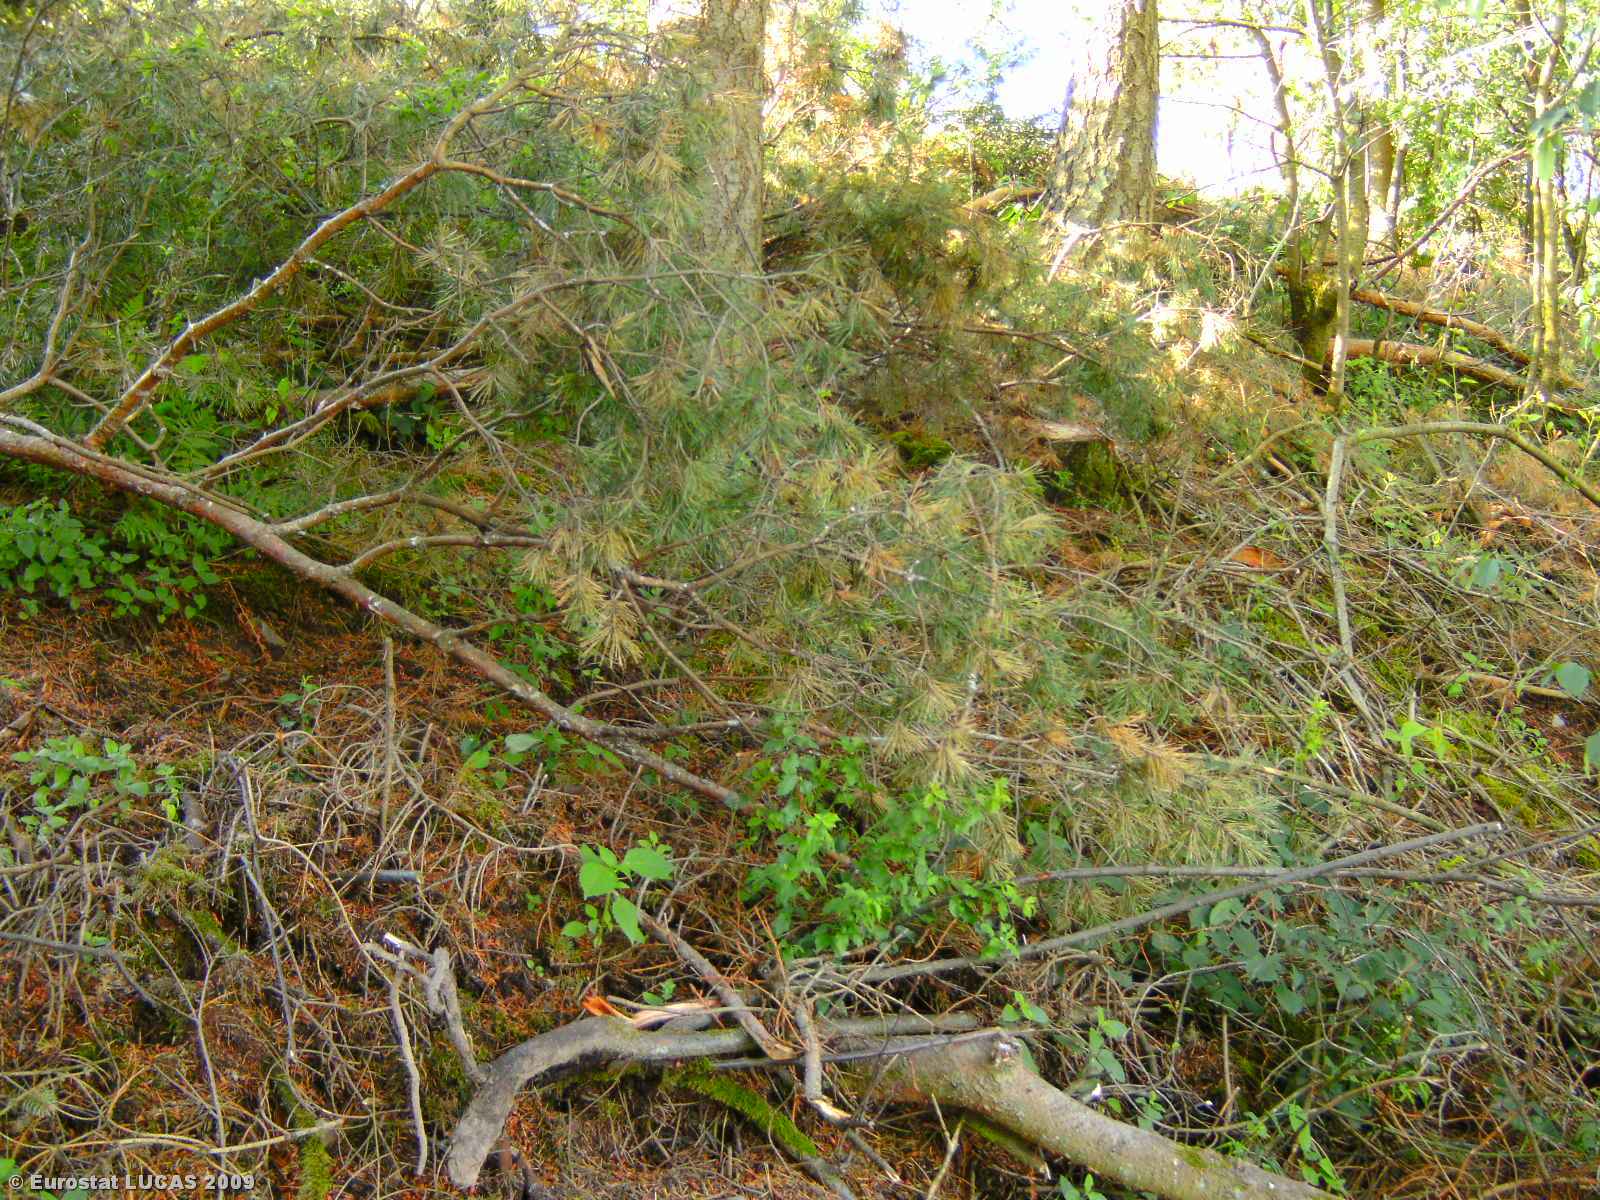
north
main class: Woodland
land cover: Coniferous woodland
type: hemiboreal forest and nemoral coniferous forest and mixed broadleaved-coniferous forest
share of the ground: > 75 %
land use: Forestry
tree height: > 5 m
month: June
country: LU
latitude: 49.9020
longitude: 6.1149
